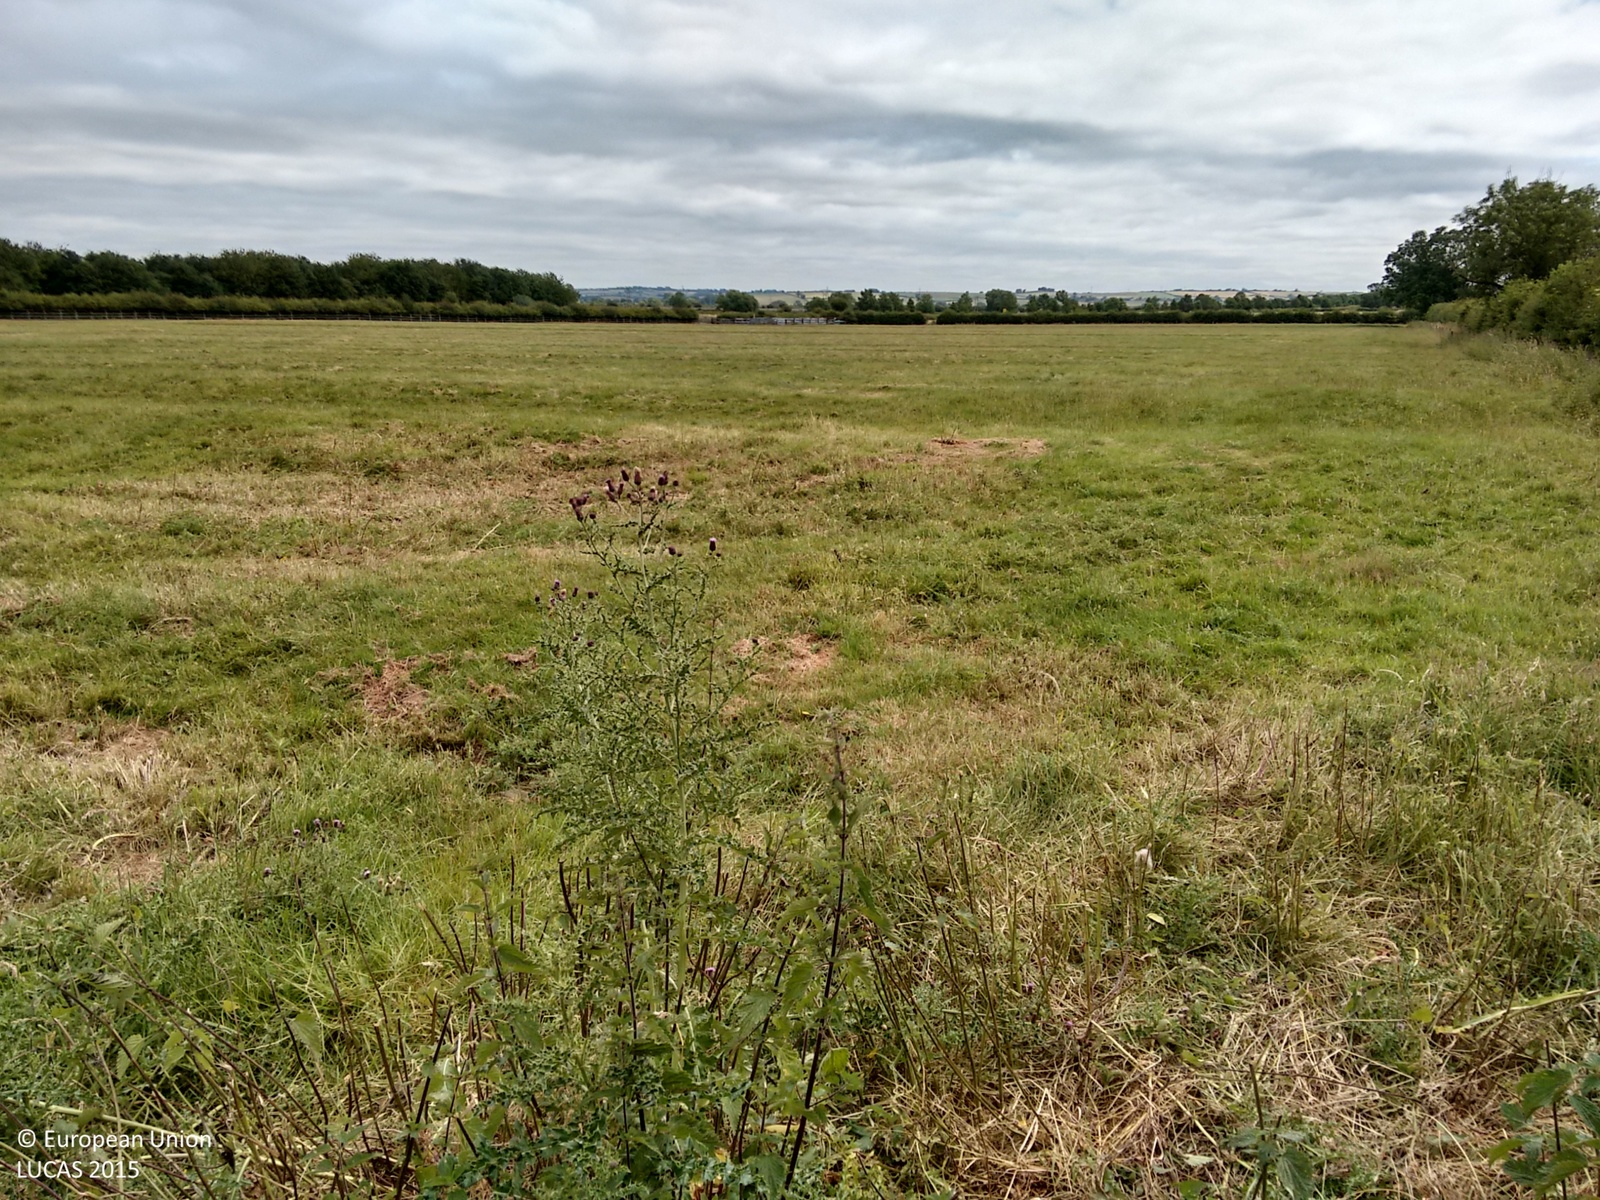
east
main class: Grassland
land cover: Grassland without tree/shrub cover
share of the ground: > 75 %
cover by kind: herbaceous plants 100 %
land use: Agriculture (excluding fallow land and kitchen gardens)
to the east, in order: Fences; Grassland without tree/shrub cover
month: July
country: GB
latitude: 52.5062
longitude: -0.9309
